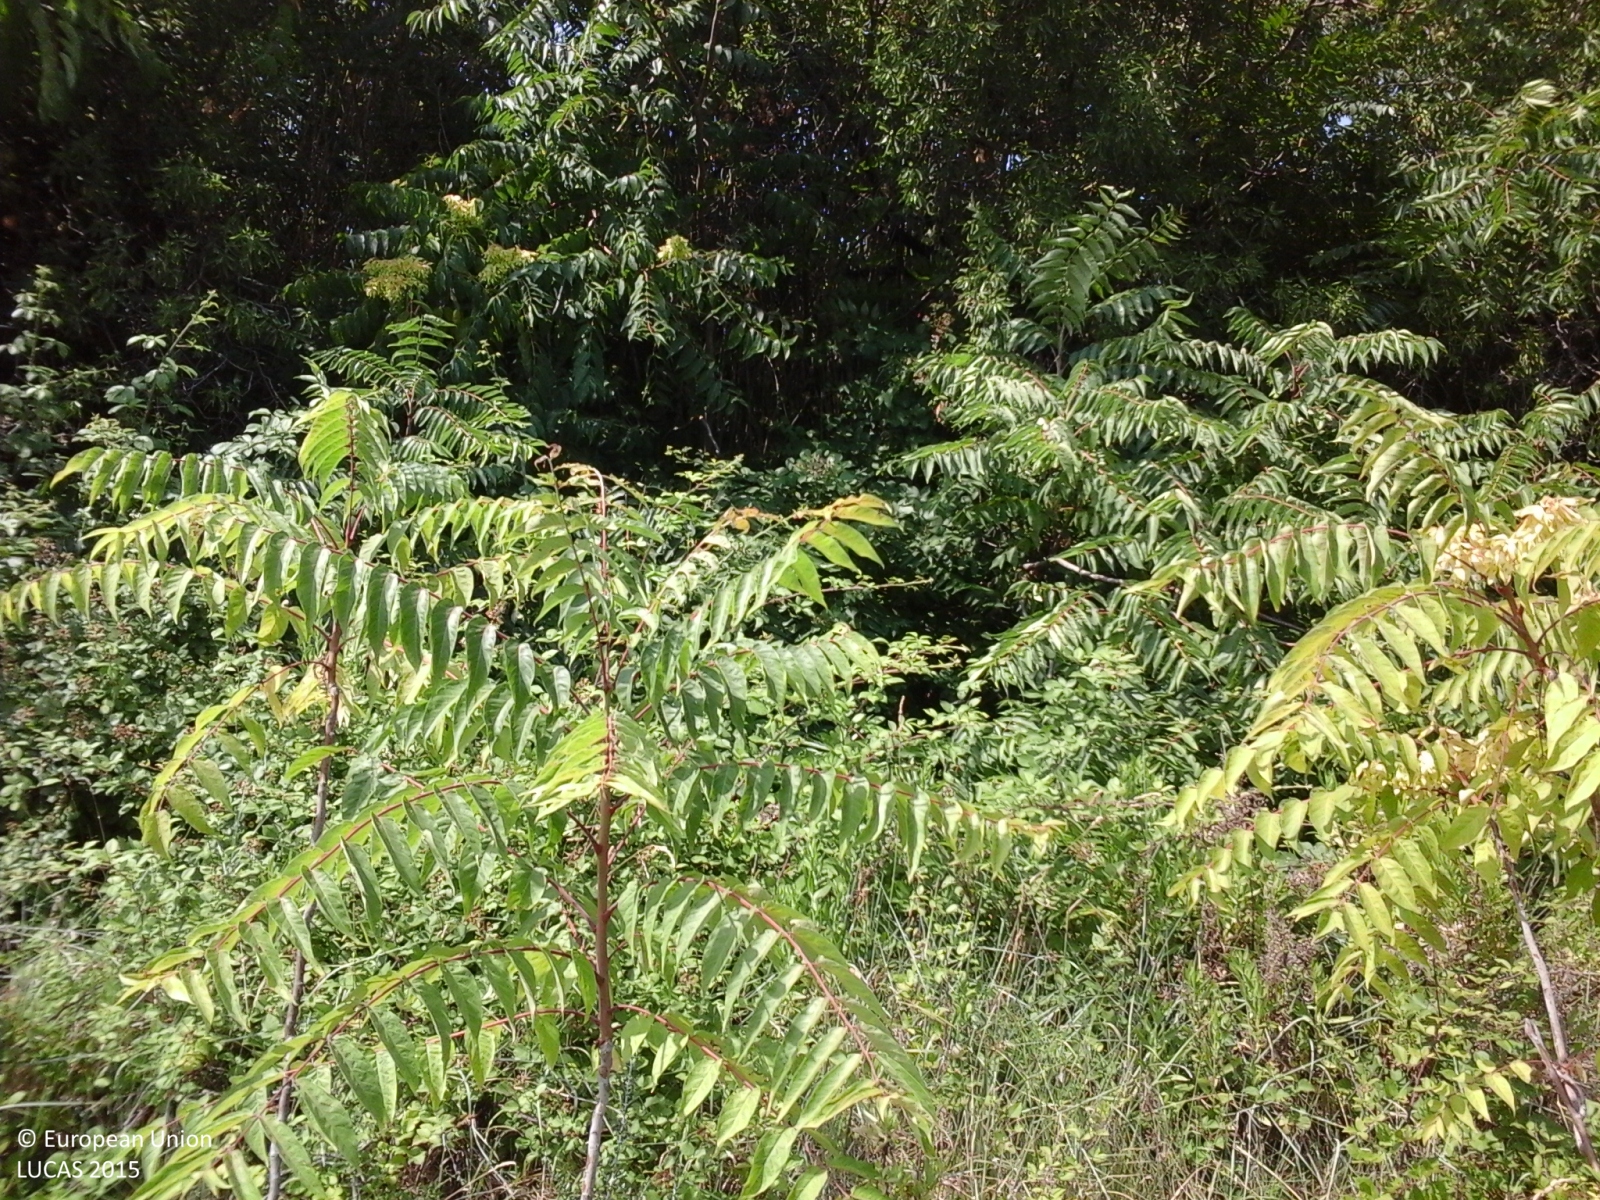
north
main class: Cropland
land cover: Olive groves
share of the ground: 10 - 25 %
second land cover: Grassland without tree/shrub cover
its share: 50 - 75 %
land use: Agriculture (excluding fallow land and kitchen gardens)
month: July
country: IT
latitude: 43.0515
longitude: 13.8326
